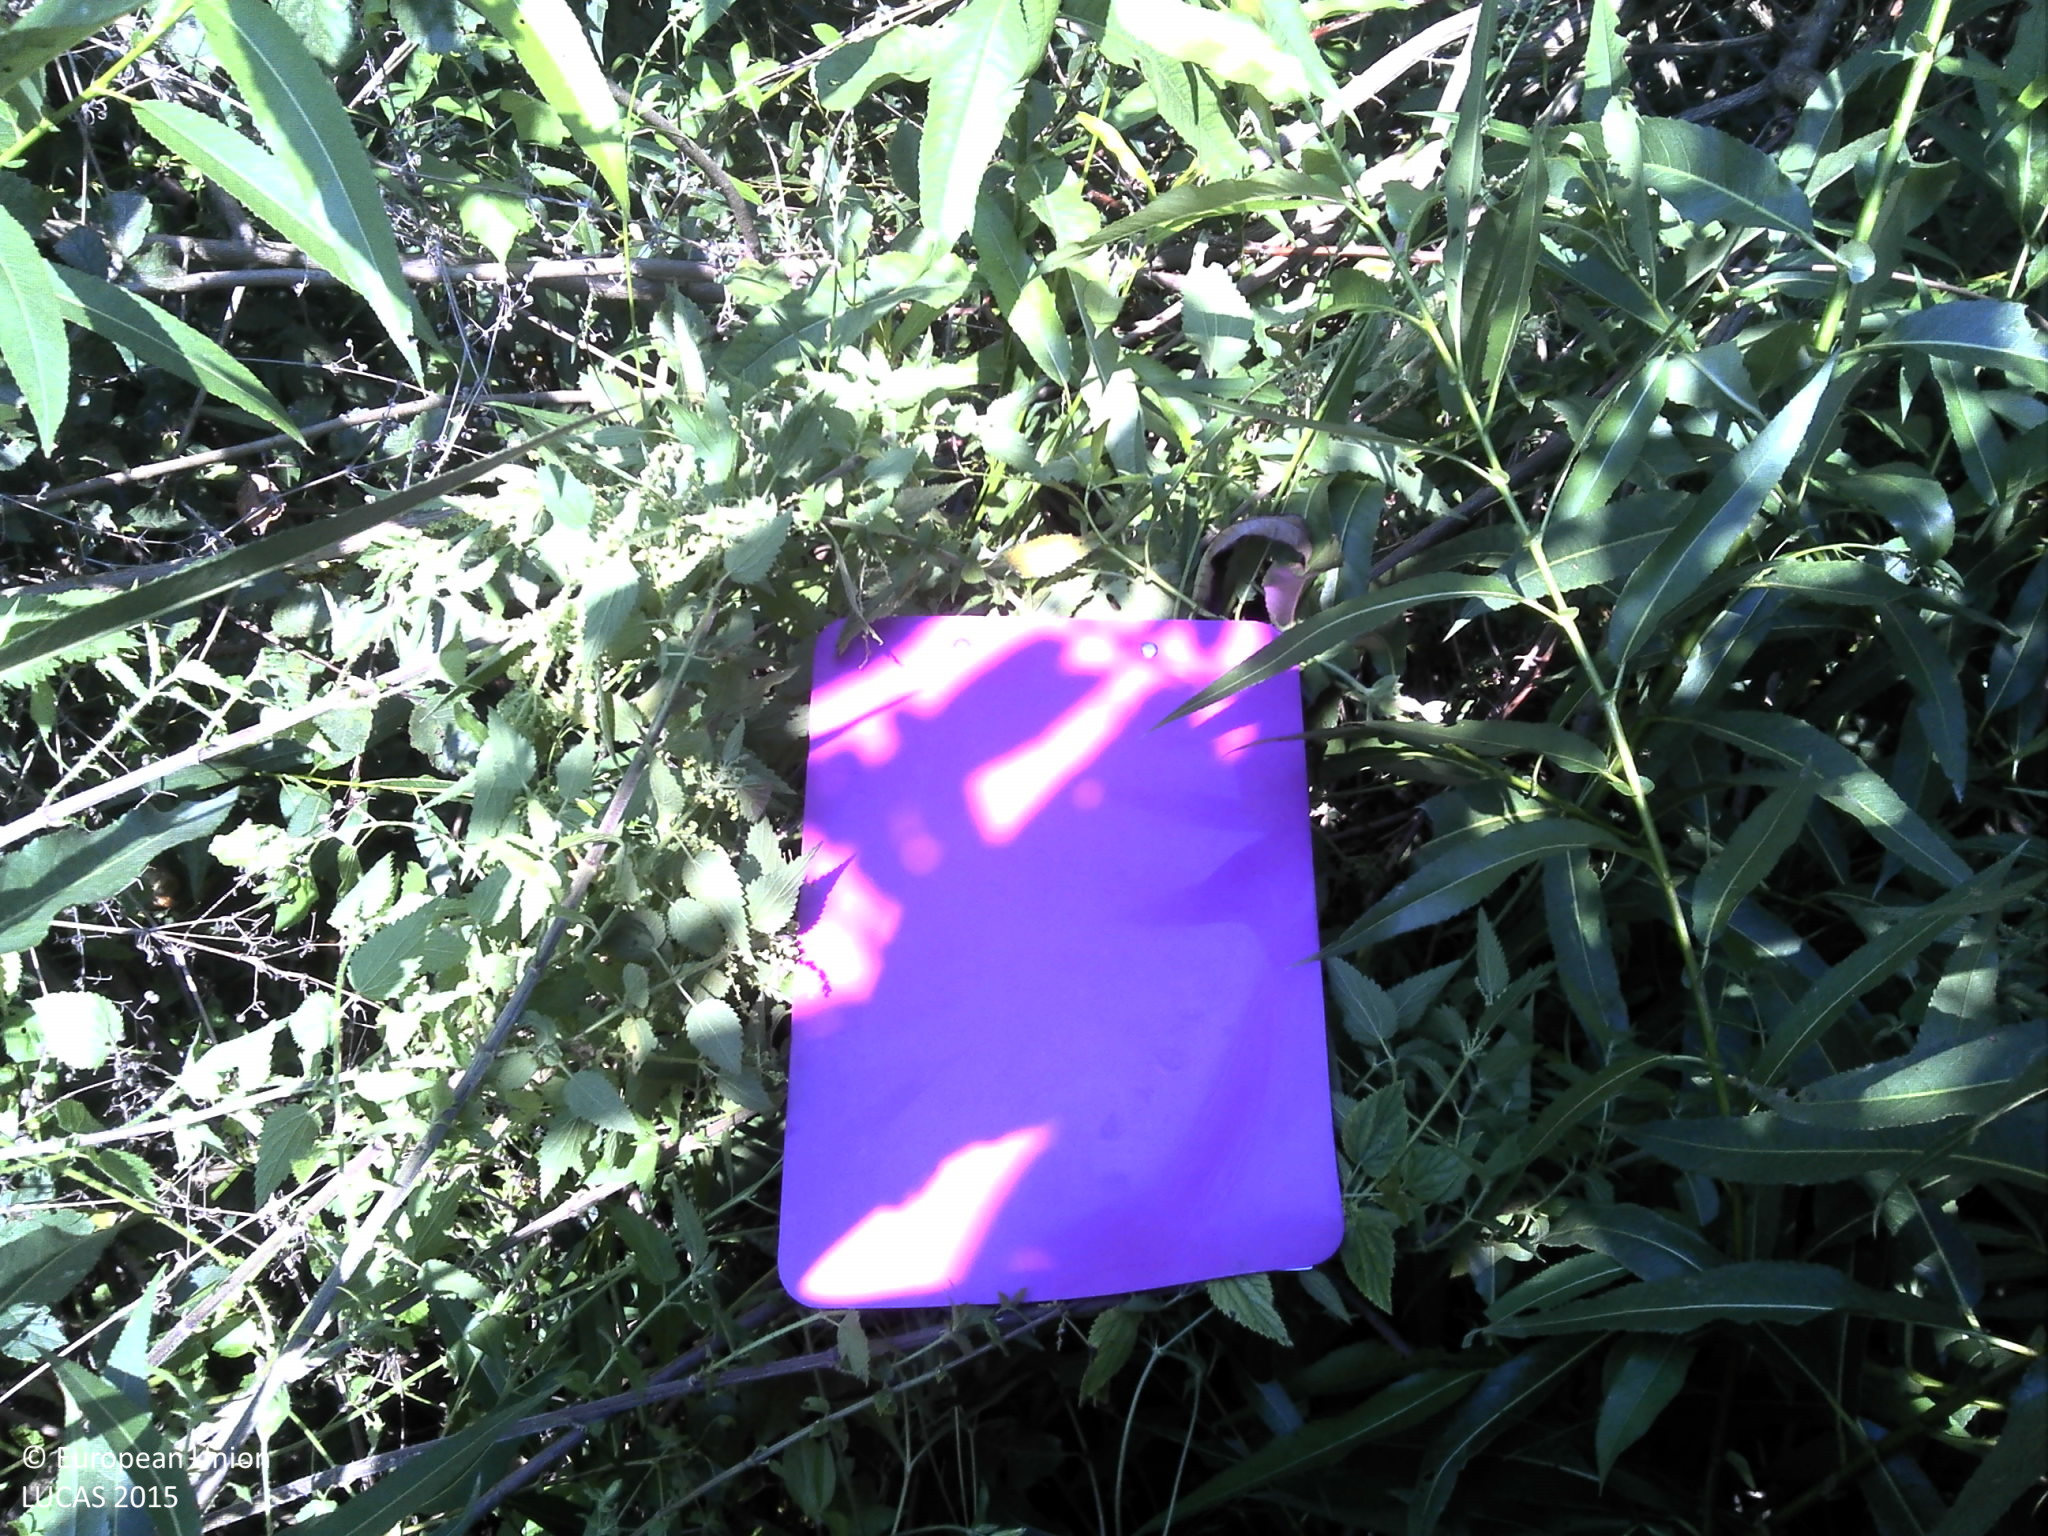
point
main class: Shrubland
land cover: Shrubland with sparse tree cover
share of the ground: > 75 %
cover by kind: shrubs 90 %, broadleaved forest trees 5 %, herbaceous plants 5 %
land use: Semi-natural and natural areas not in use
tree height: < 5 m
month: August
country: HR
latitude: 45.3171
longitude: 16.2860
